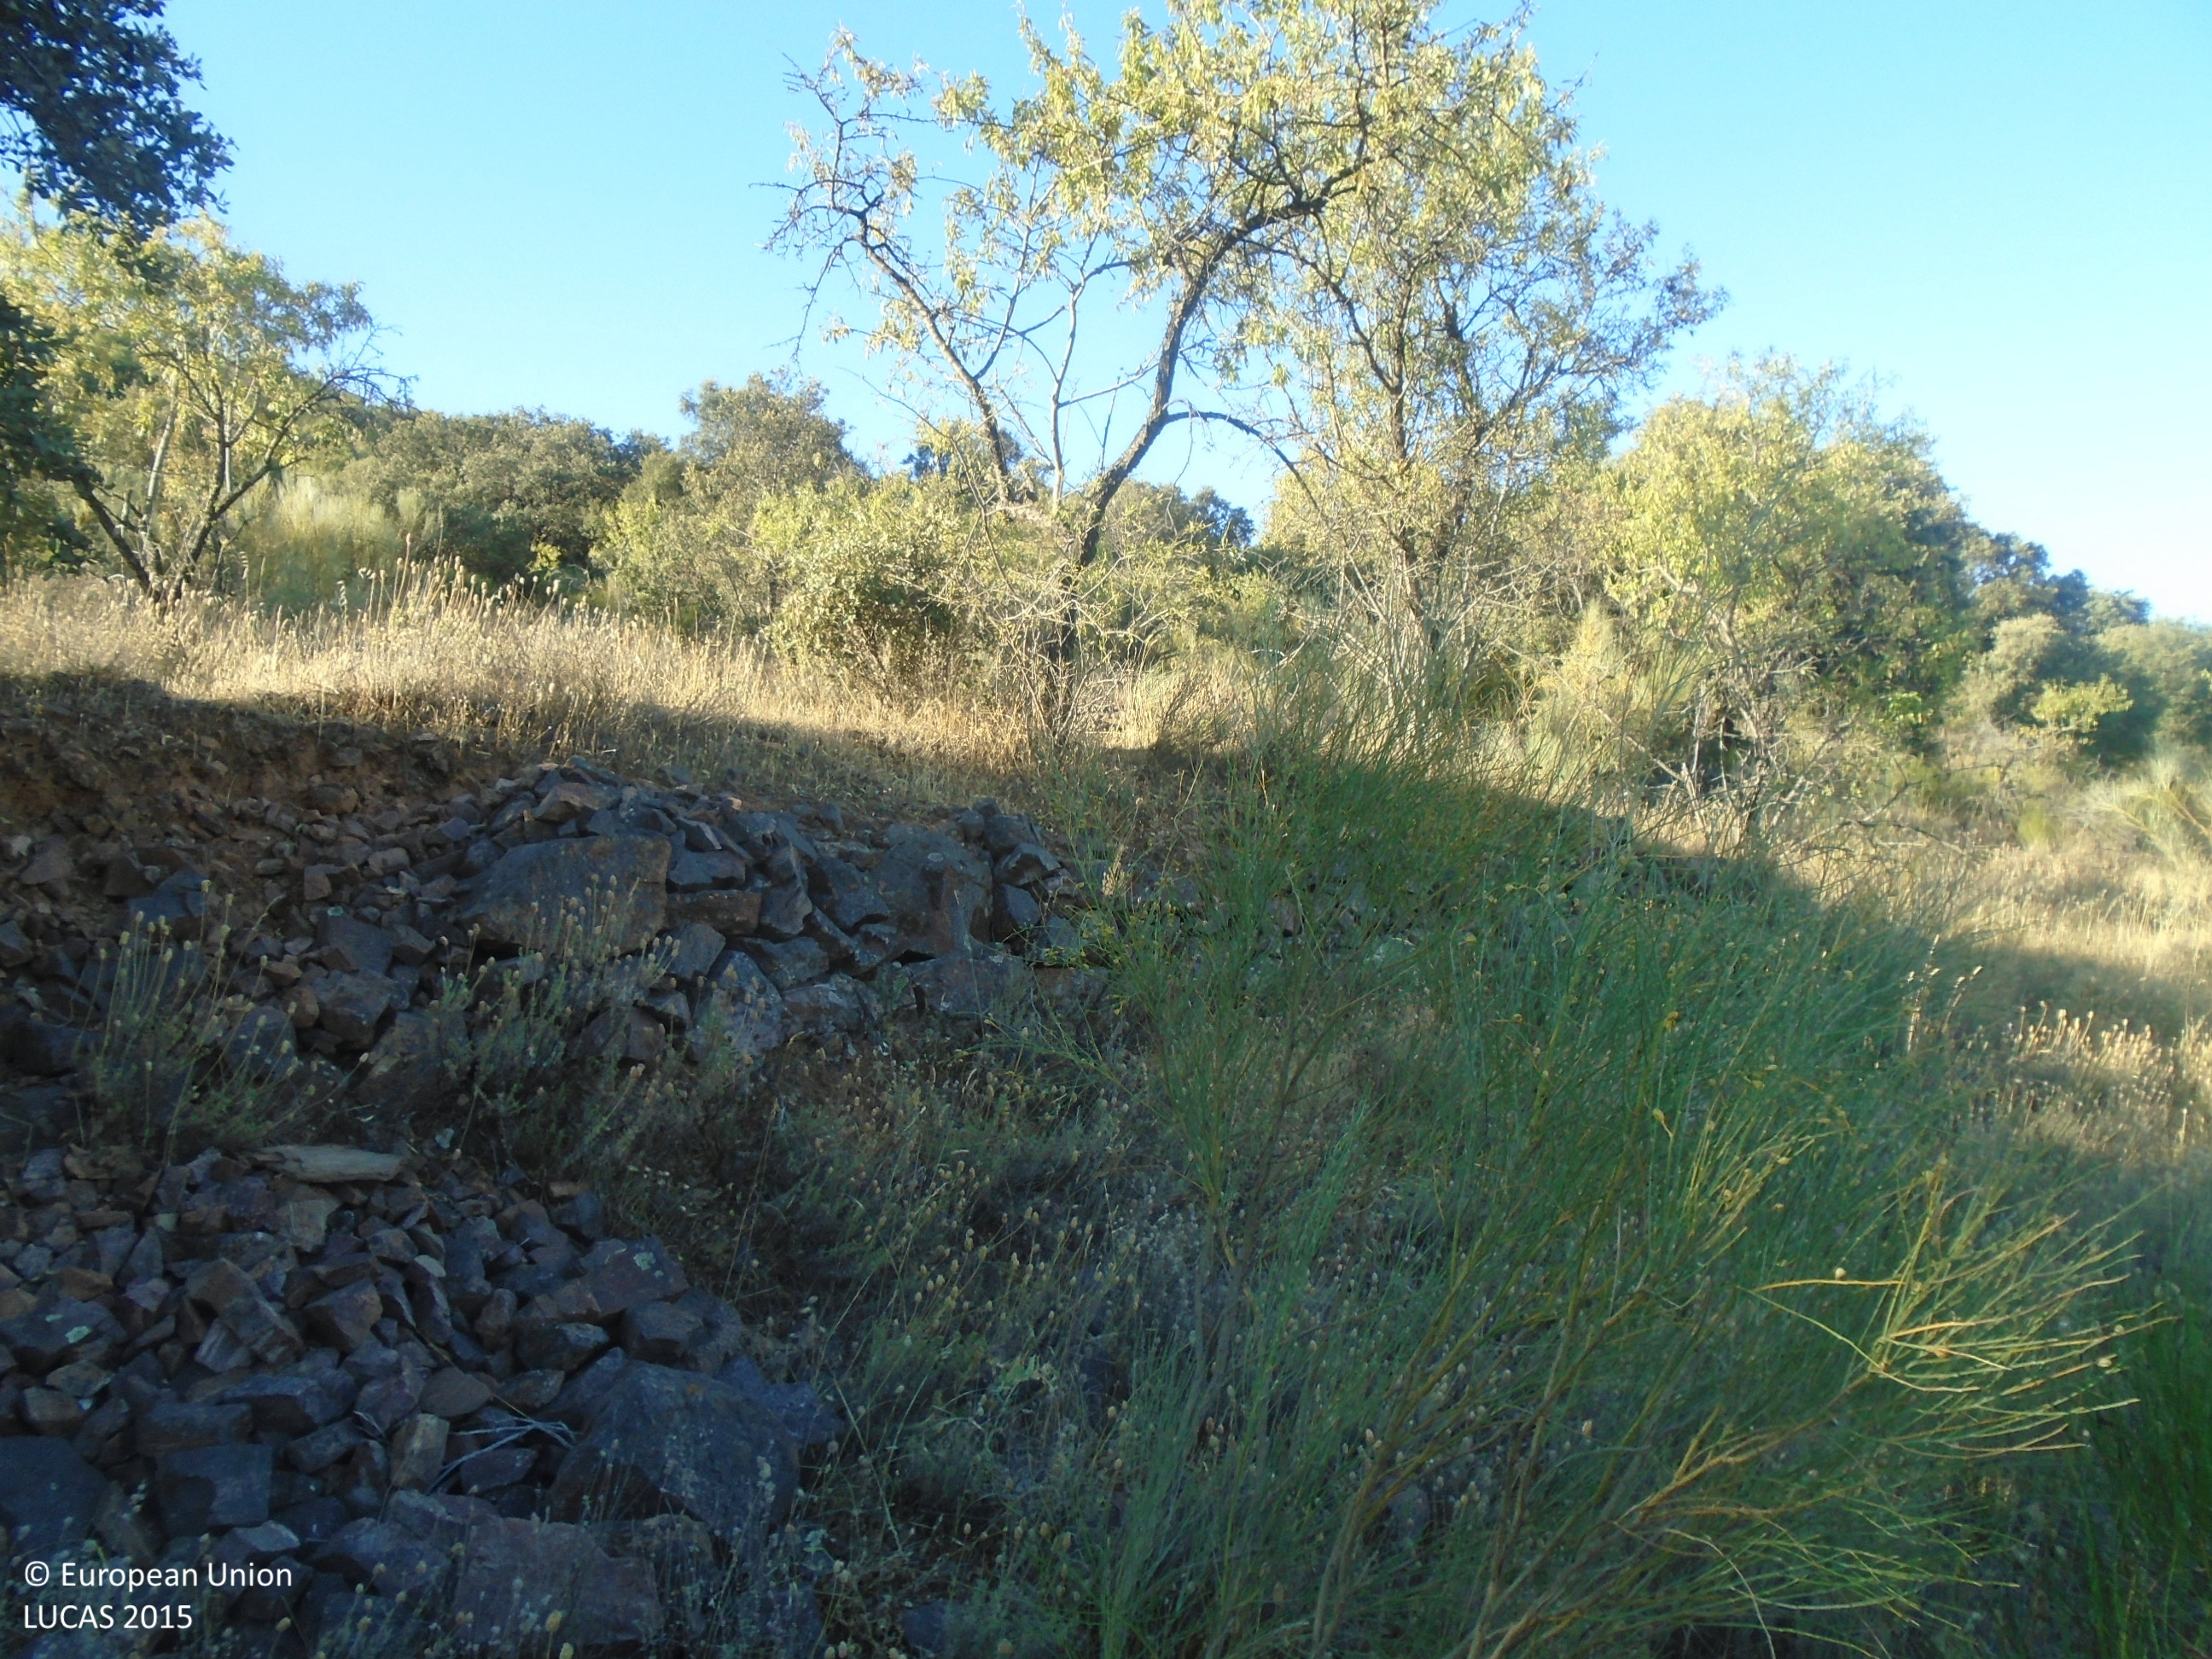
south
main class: Shrubland
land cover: Shrubland with sparse tree cover
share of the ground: > 75 %
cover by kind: shrubs 85 %, herbaceous plants 10 %, broadleaved forest trees 5 %
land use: Semi-natural and natural areas not in use
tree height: < 5 m
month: July
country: ES
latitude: 39.7003
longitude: -5.0809
